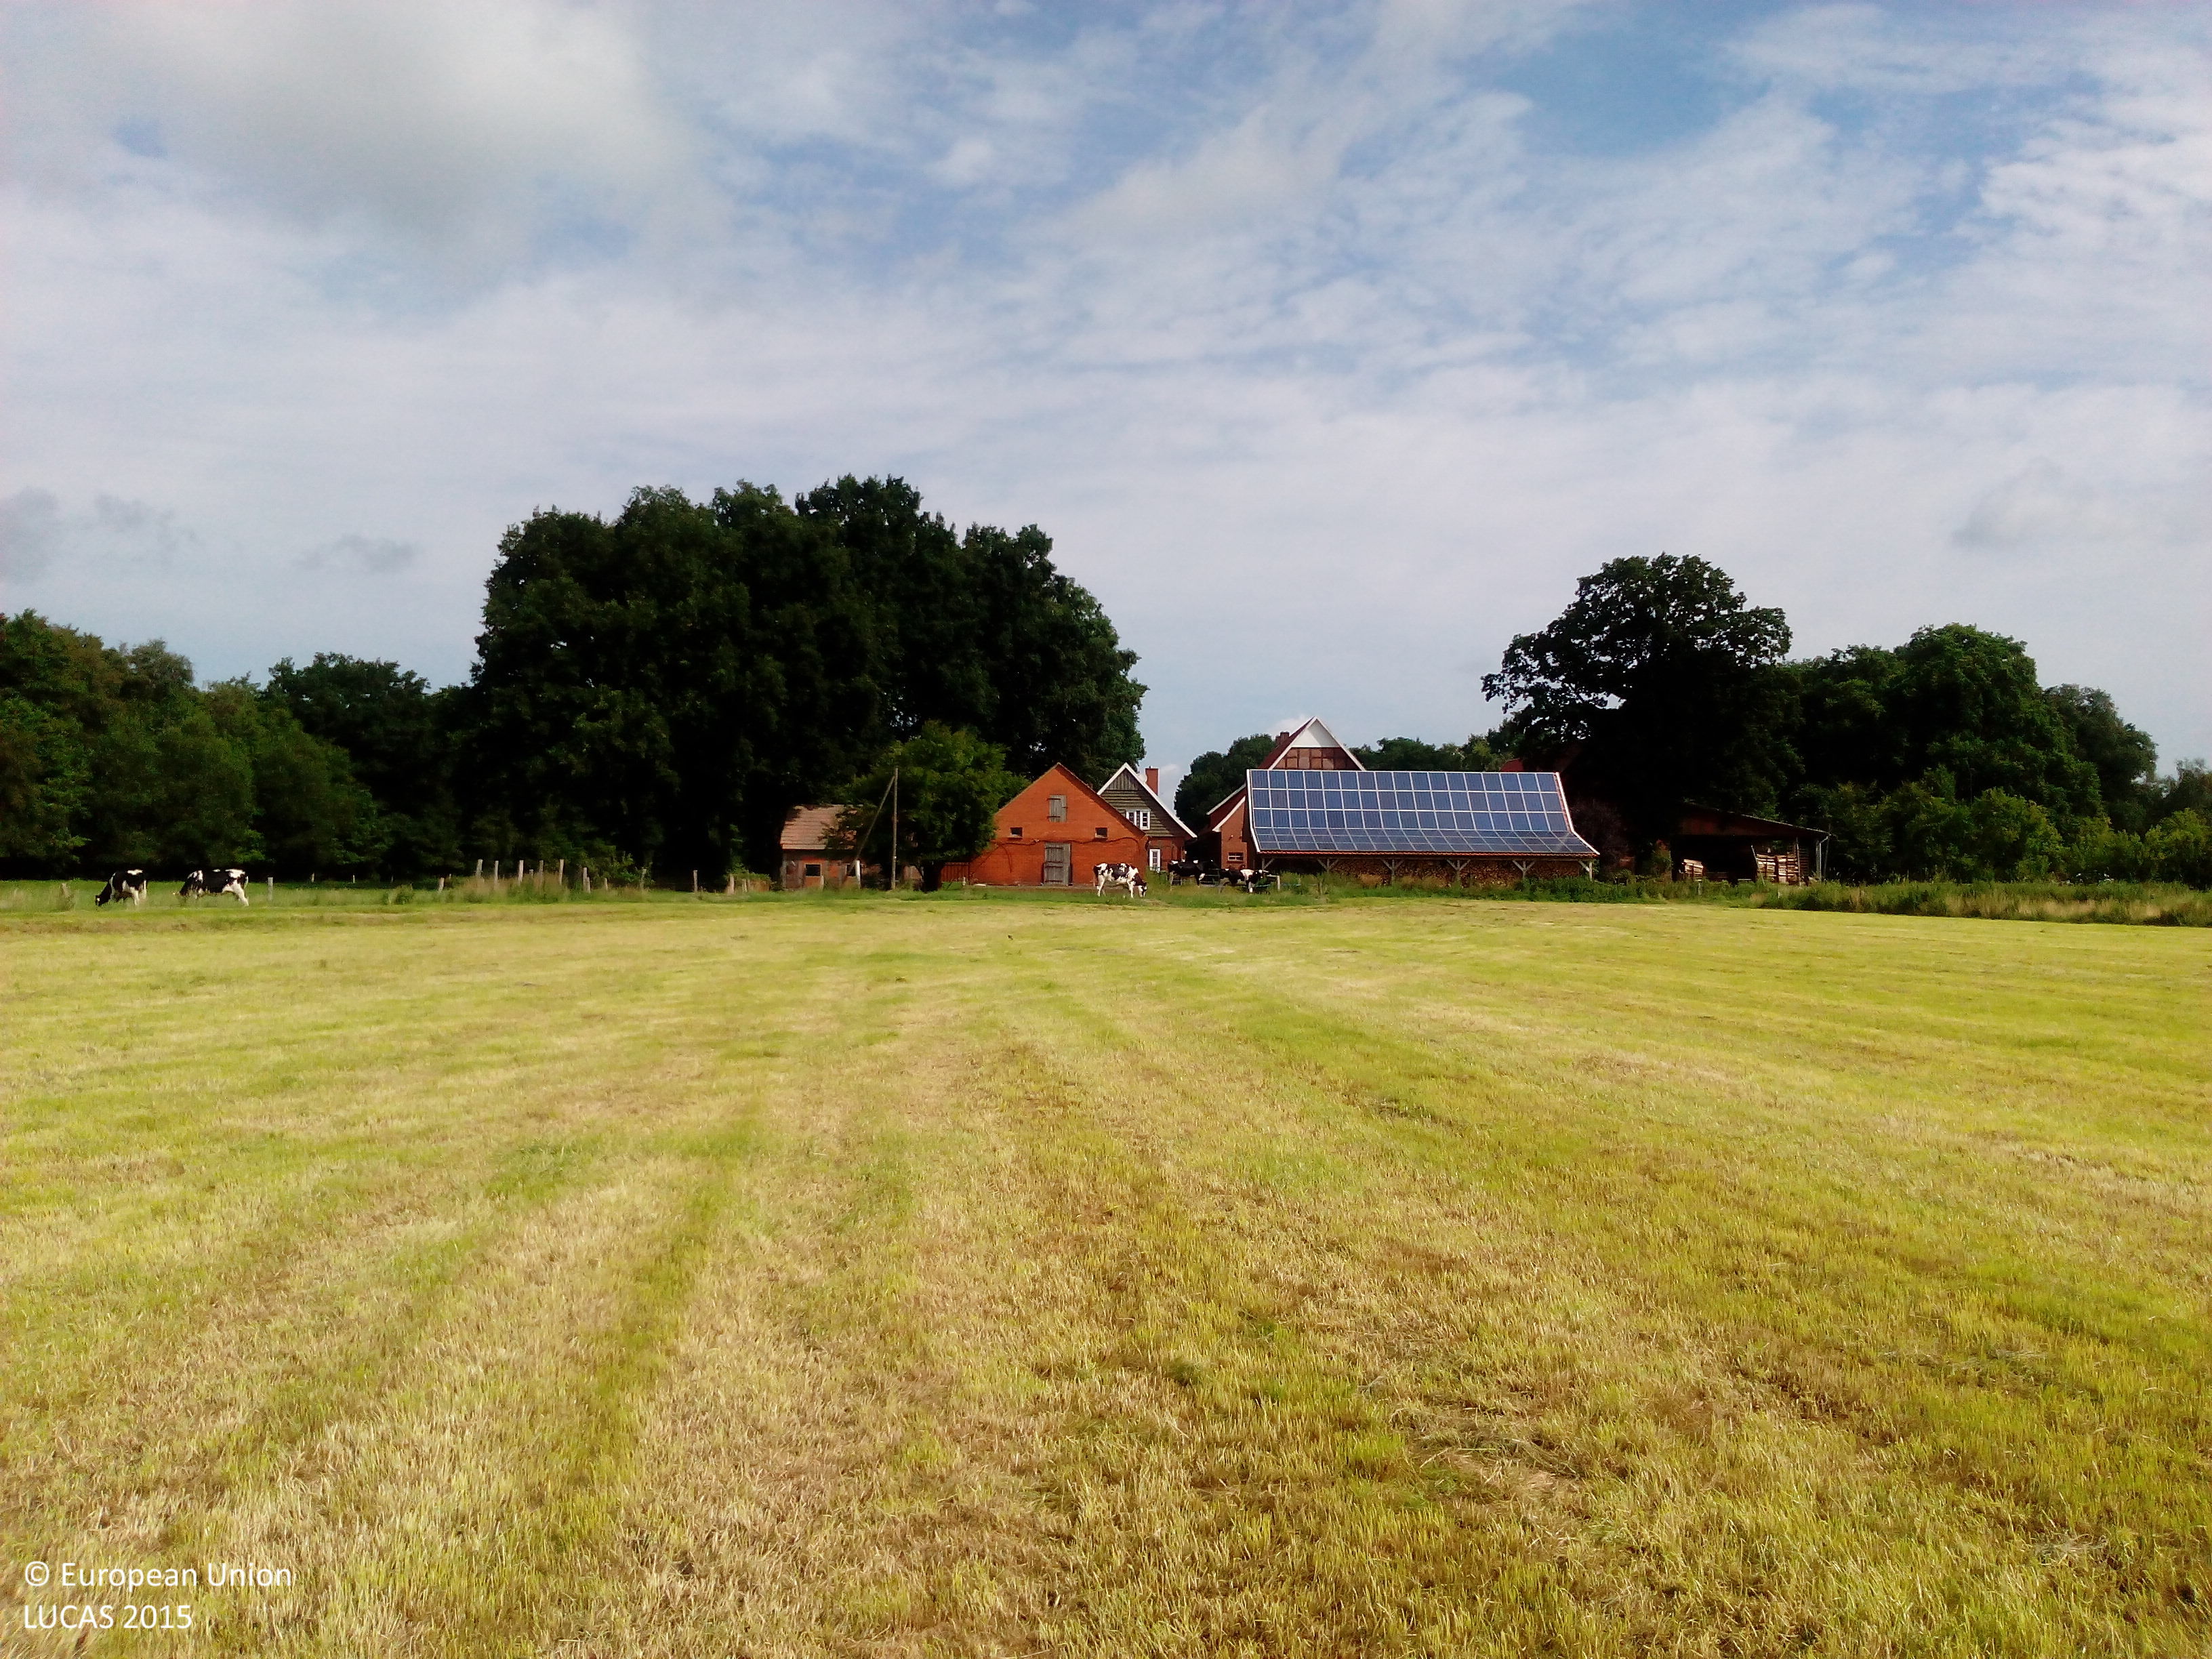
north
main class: Grassland
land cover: Grassland without tree/shrub cover
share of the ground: > 75 %
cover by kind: herbaceous plants 100 %
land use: Agriculture (excluding fallow land and kitchen gardens)
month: July
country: DE
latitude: 52.5945
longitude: 8.0076
